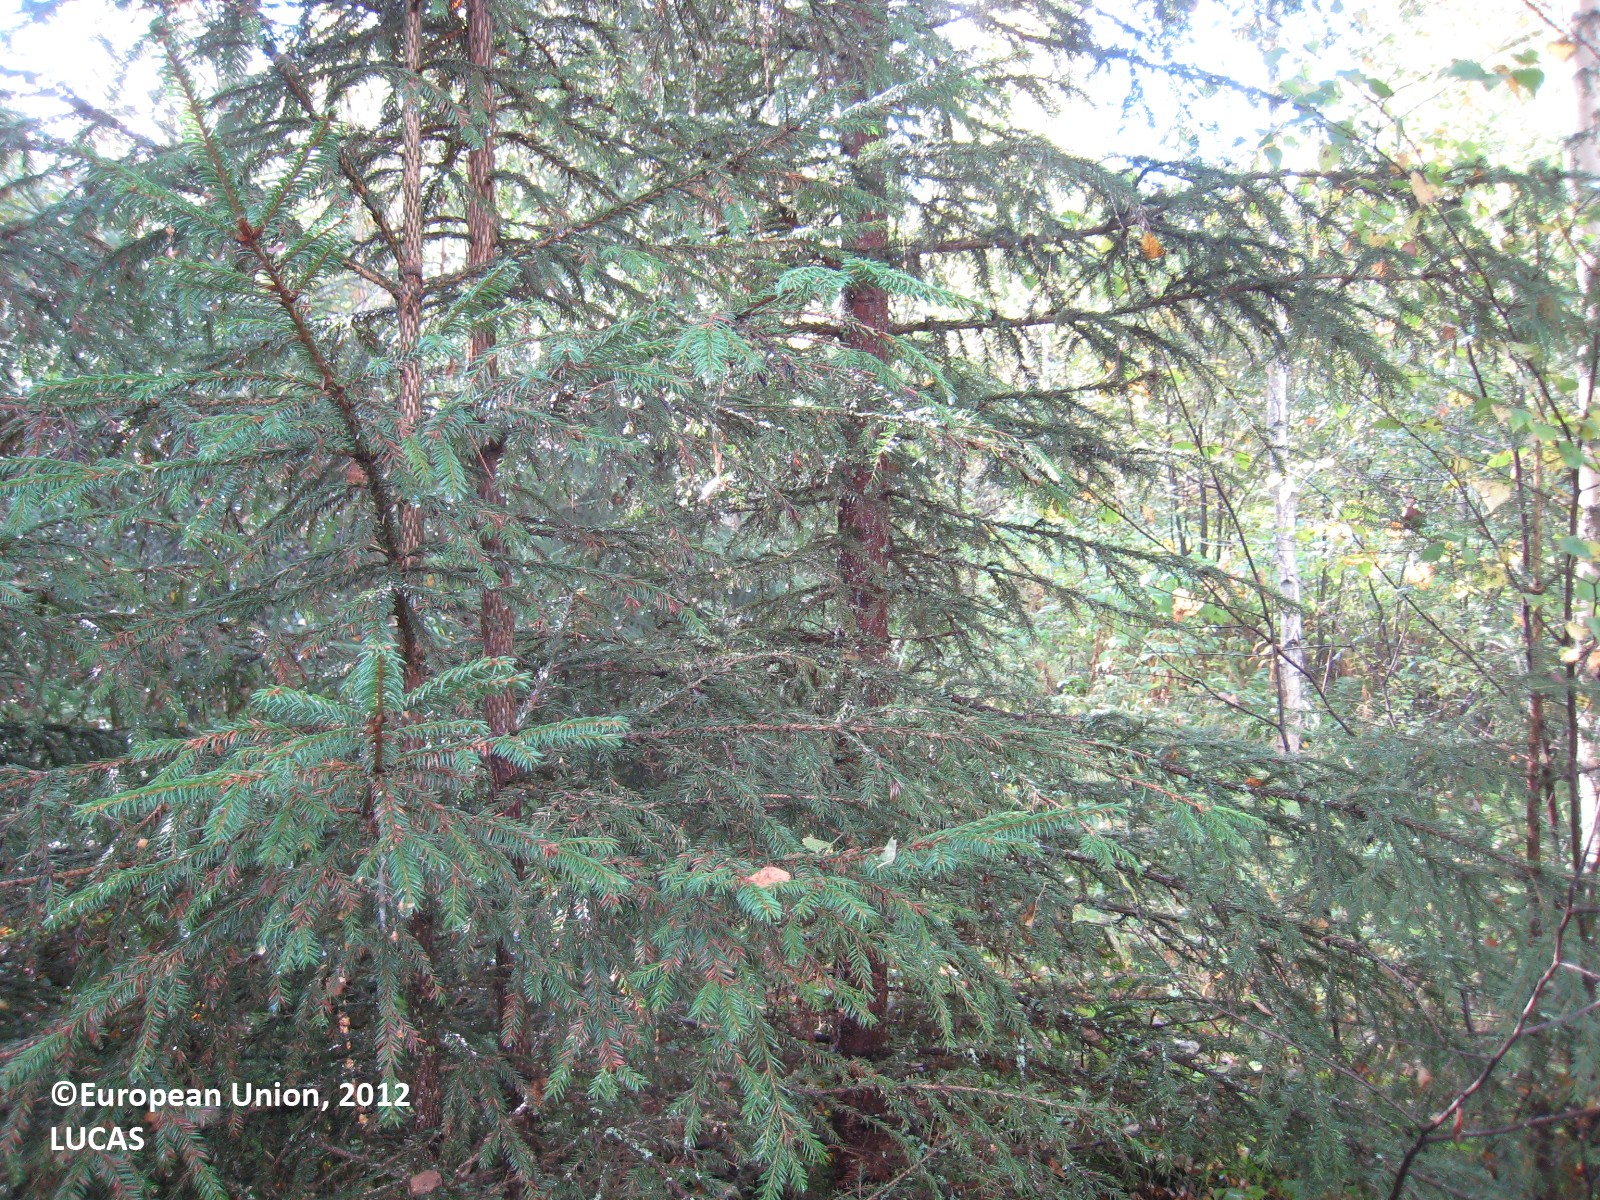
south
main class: Woodland
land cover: Spruce dominated mixed woodland
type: boreal forest
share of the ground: > 75 %
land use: Forestry
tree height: > 5 m
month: September
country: FI
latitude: 63.1110
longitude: 26.7257
